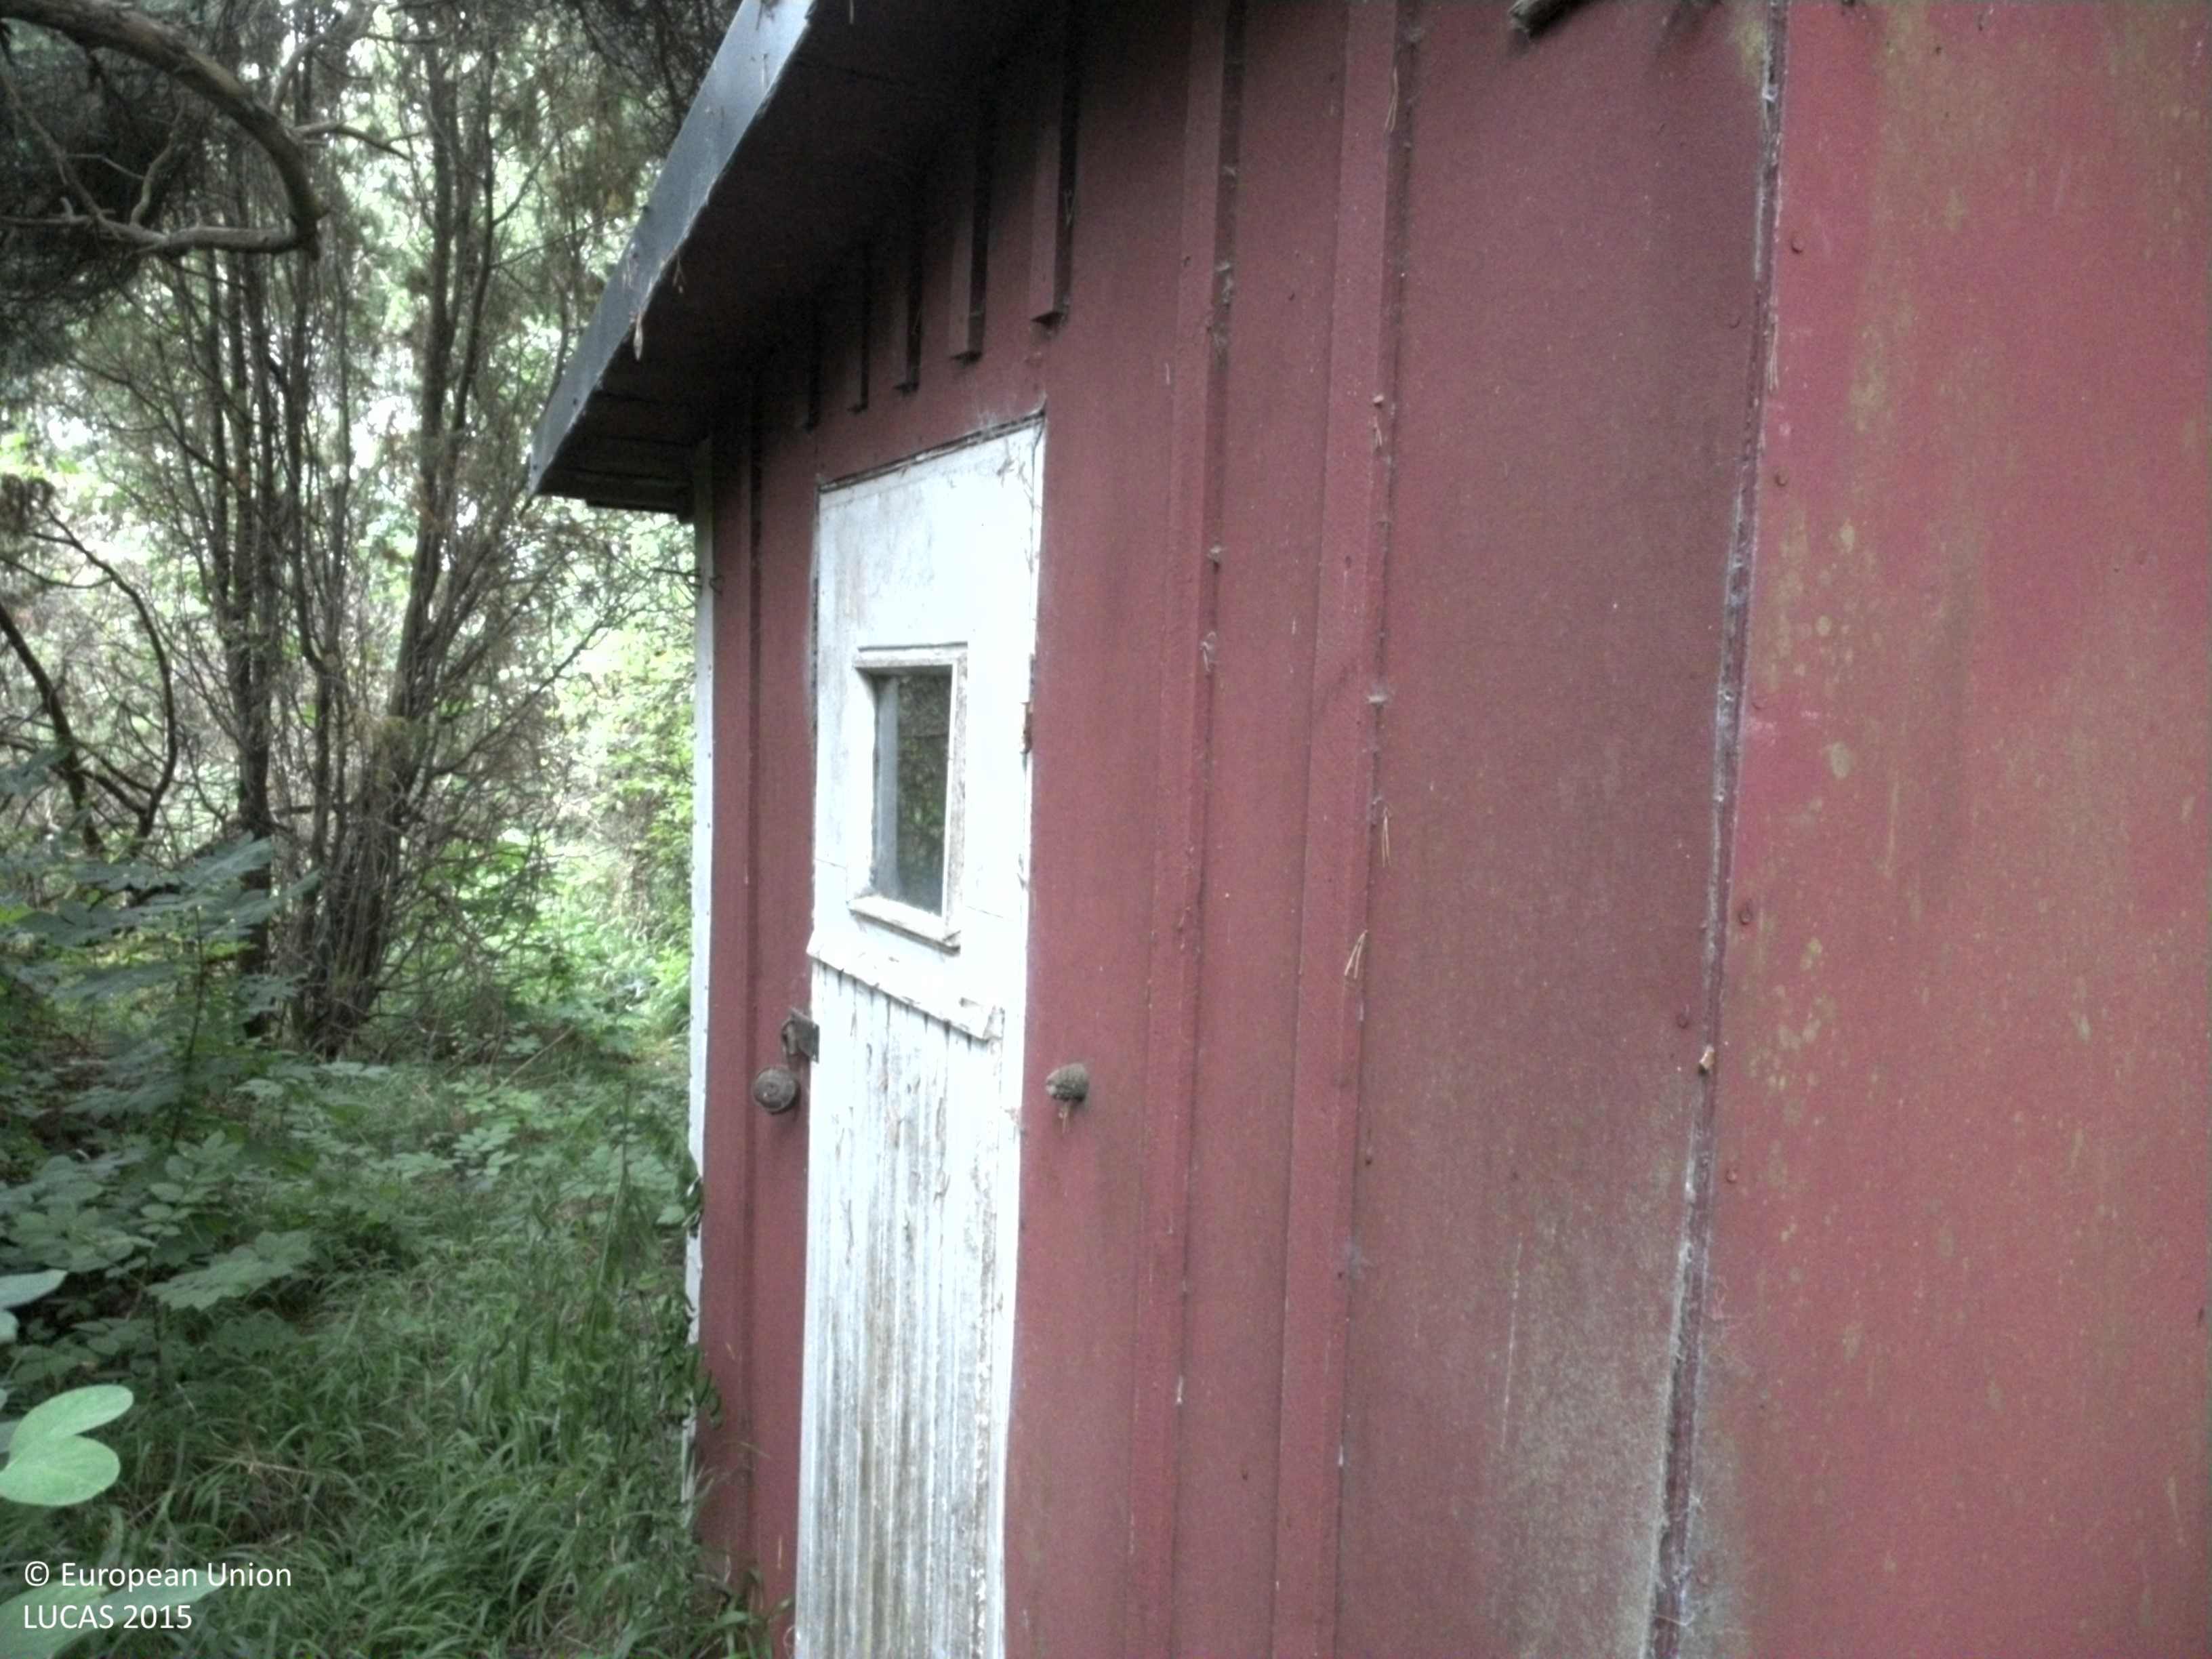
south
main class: Woodland
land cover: Pine dominated coniferous woodland
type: hemiboreal forest and nemoral coniferous forest and mixed broadleaved-coniferous forest
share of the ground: > 75 %
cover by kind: coniferous forest trees 75 %, shrubs 15 %, broadleaved forest trees 5 %, herbaceous plants 5 %
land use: Forestry
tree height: > 5 m
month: July
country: SE
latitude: 57.2214
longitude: 18.5723
